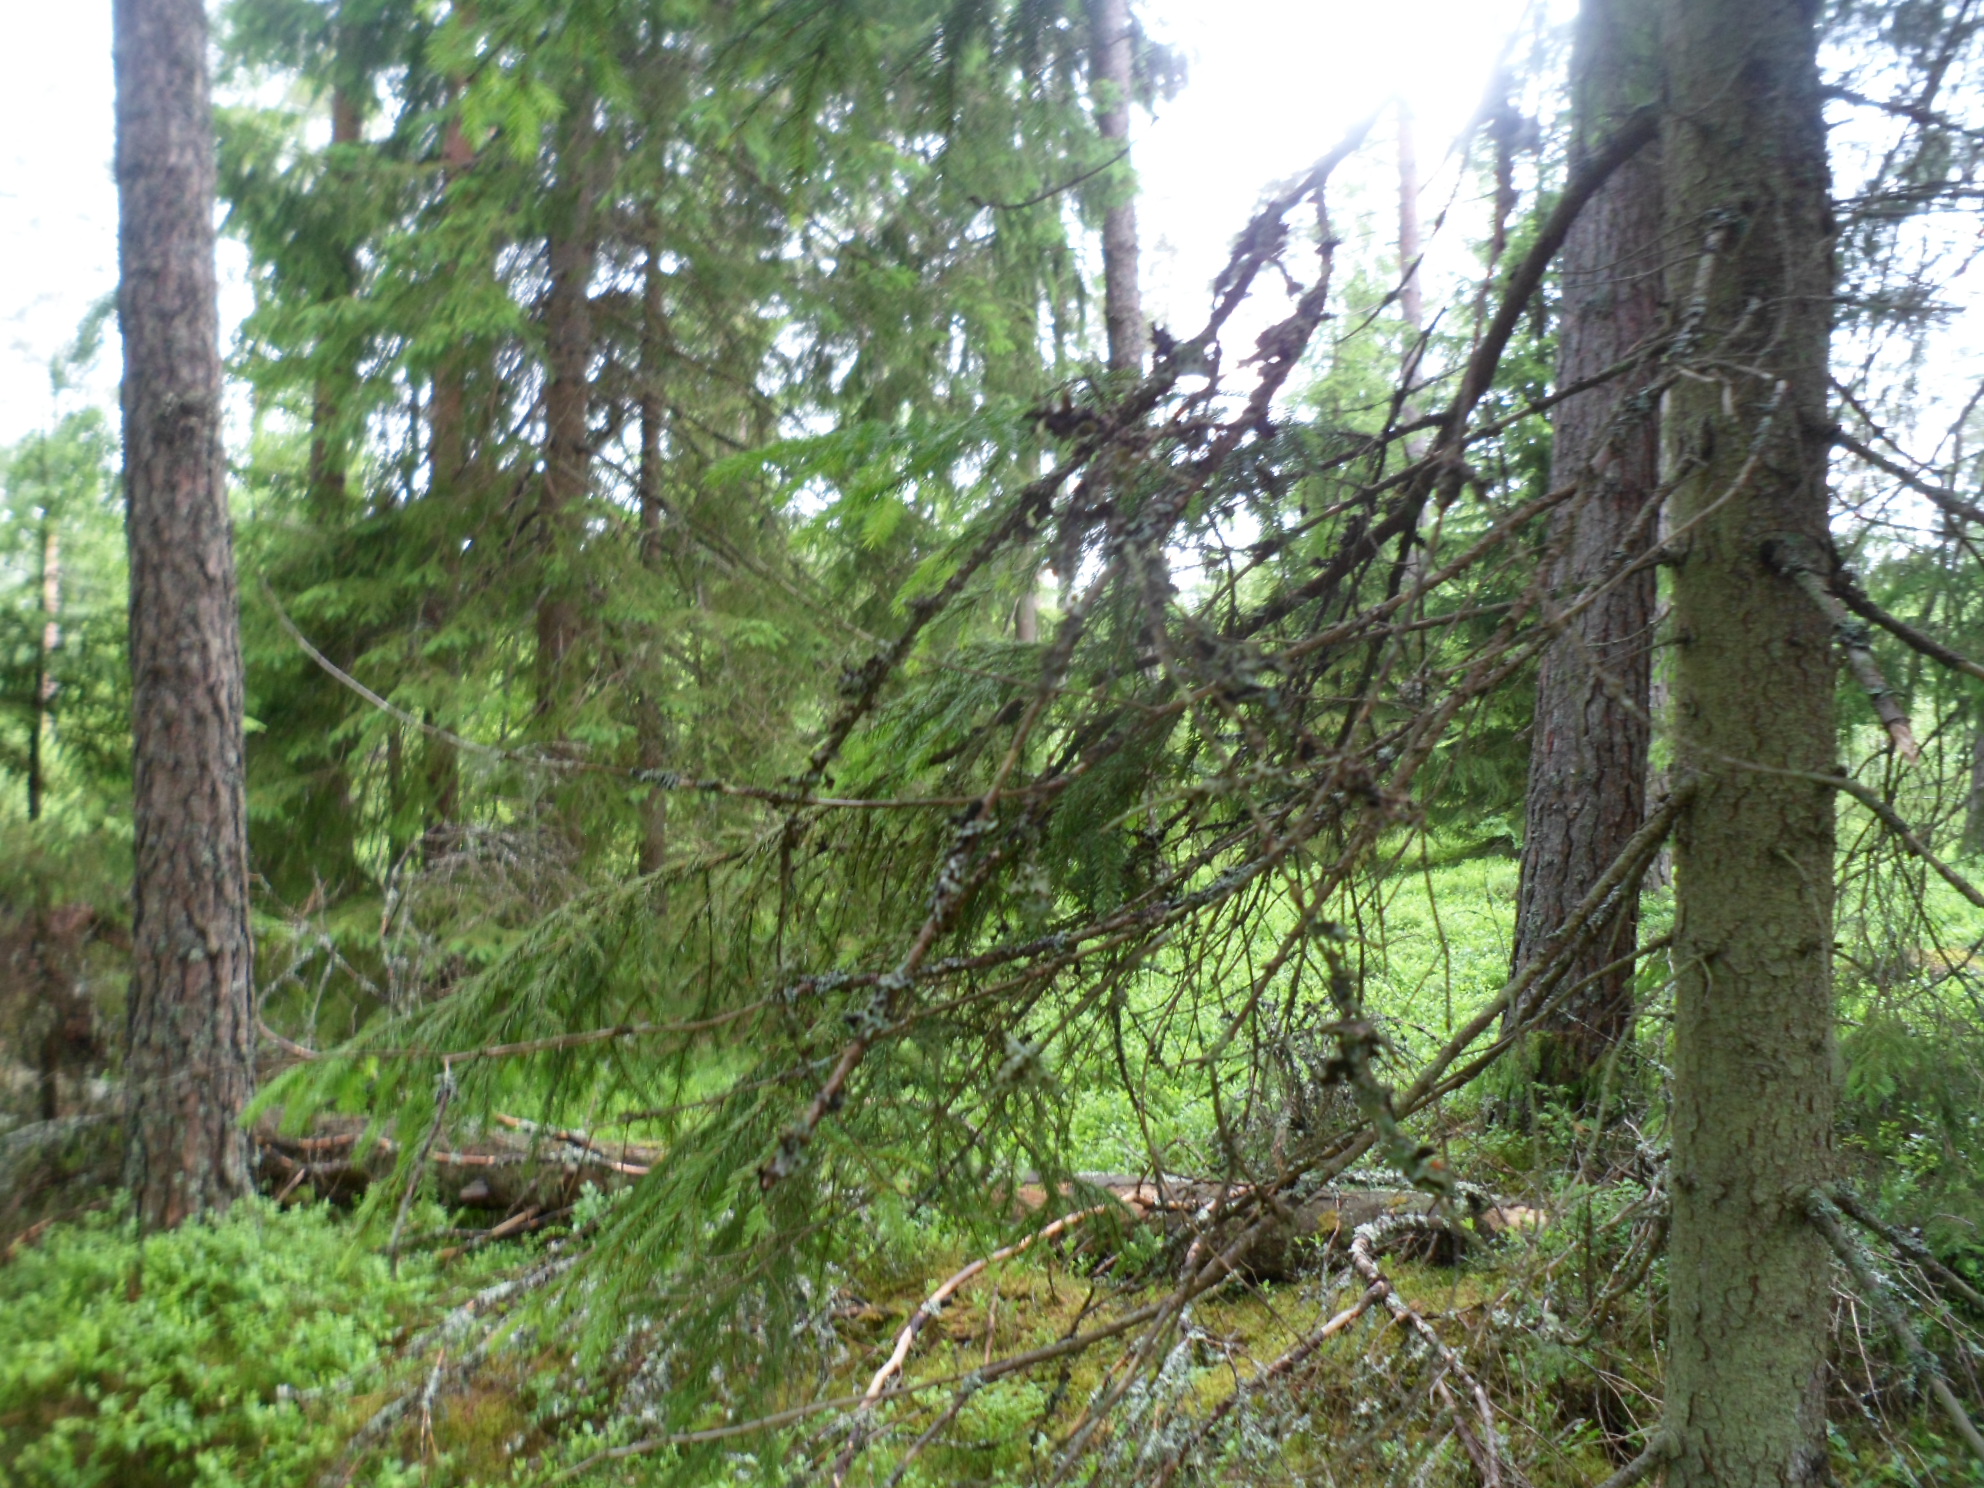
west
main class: Woodland
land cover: Spruce dominated coniferous woodland
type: boreal forest
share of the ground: 50 - 75 %
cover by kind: coniferous forest trees 55 %, shrubs 30 %, lichens and mosses 10 %, herbaceous plants 5 %
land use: Forestry
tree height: > 5 m
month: June
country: SE
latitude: 57.1455
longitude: 15.2032
